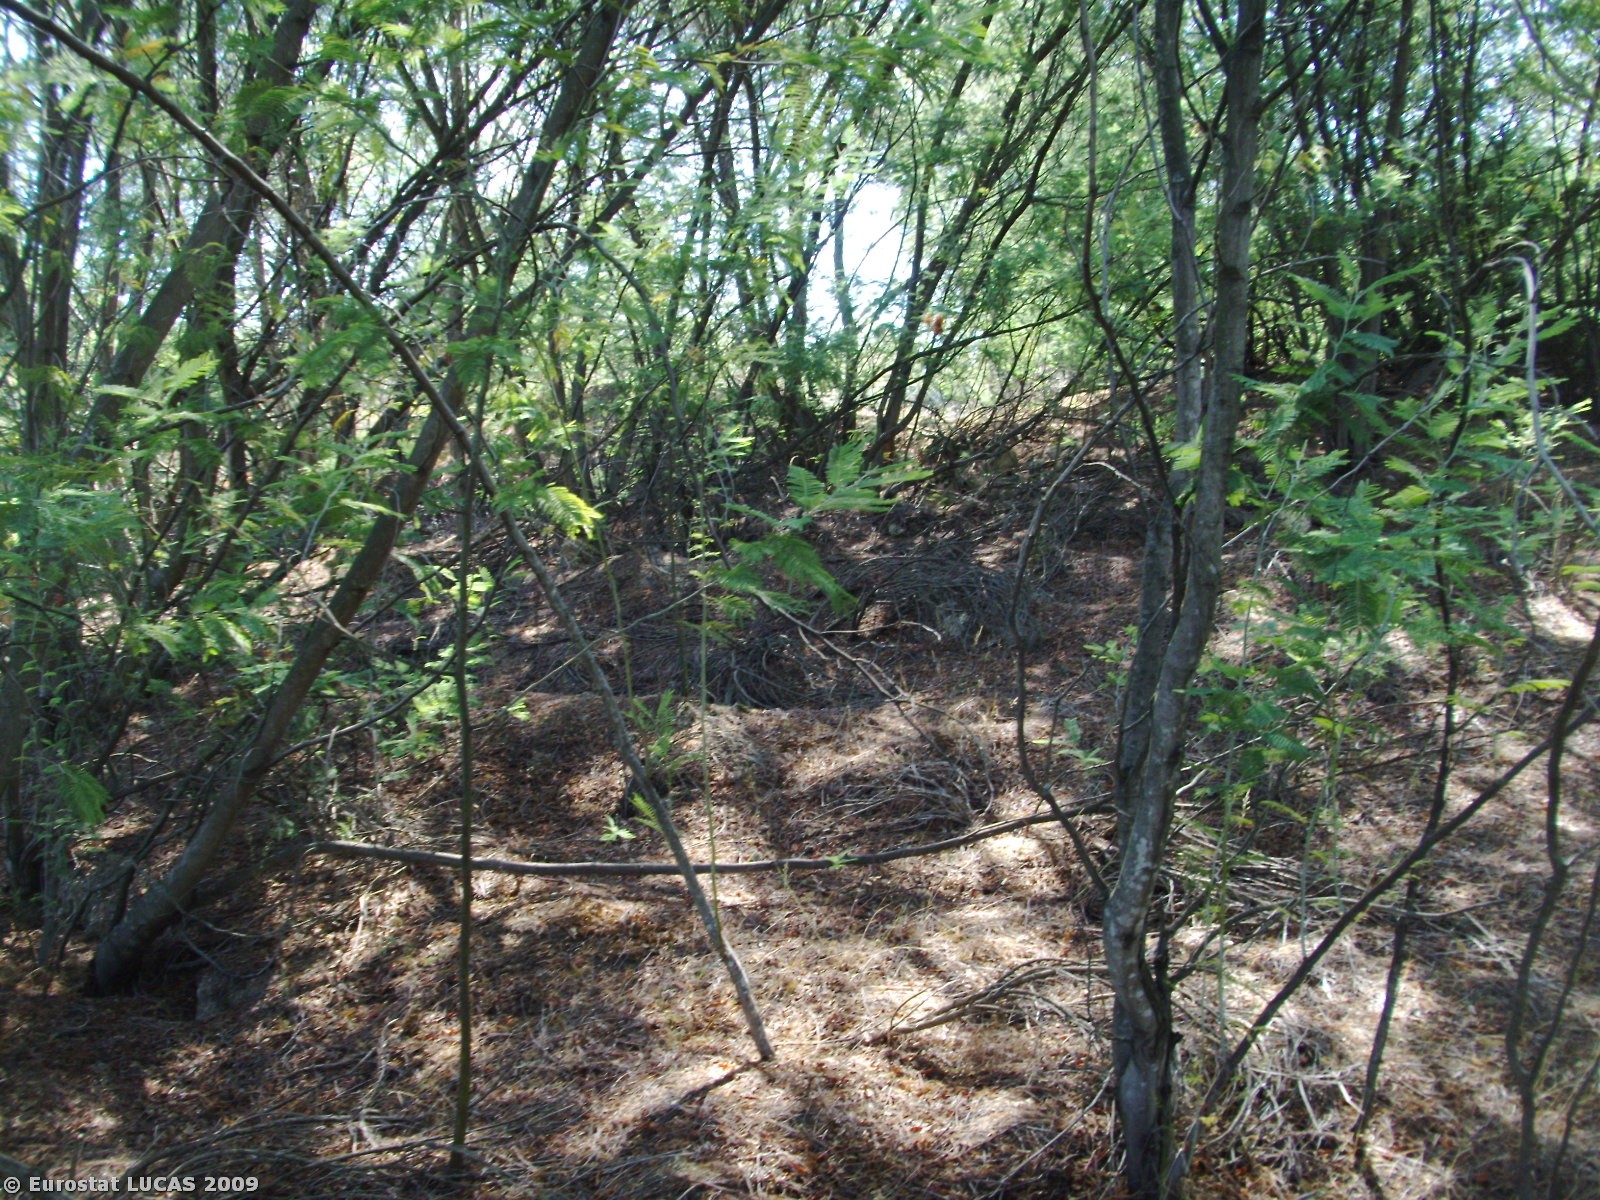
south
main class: Woodland
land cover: Broadleaved woodland
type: mesophytic deciduous forest
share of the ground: > 75 %
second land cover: Bare land
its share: < 10 %
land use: Forestry
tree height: > 5 m
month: July
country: PT
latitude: 40.3931
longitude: -7.3168
